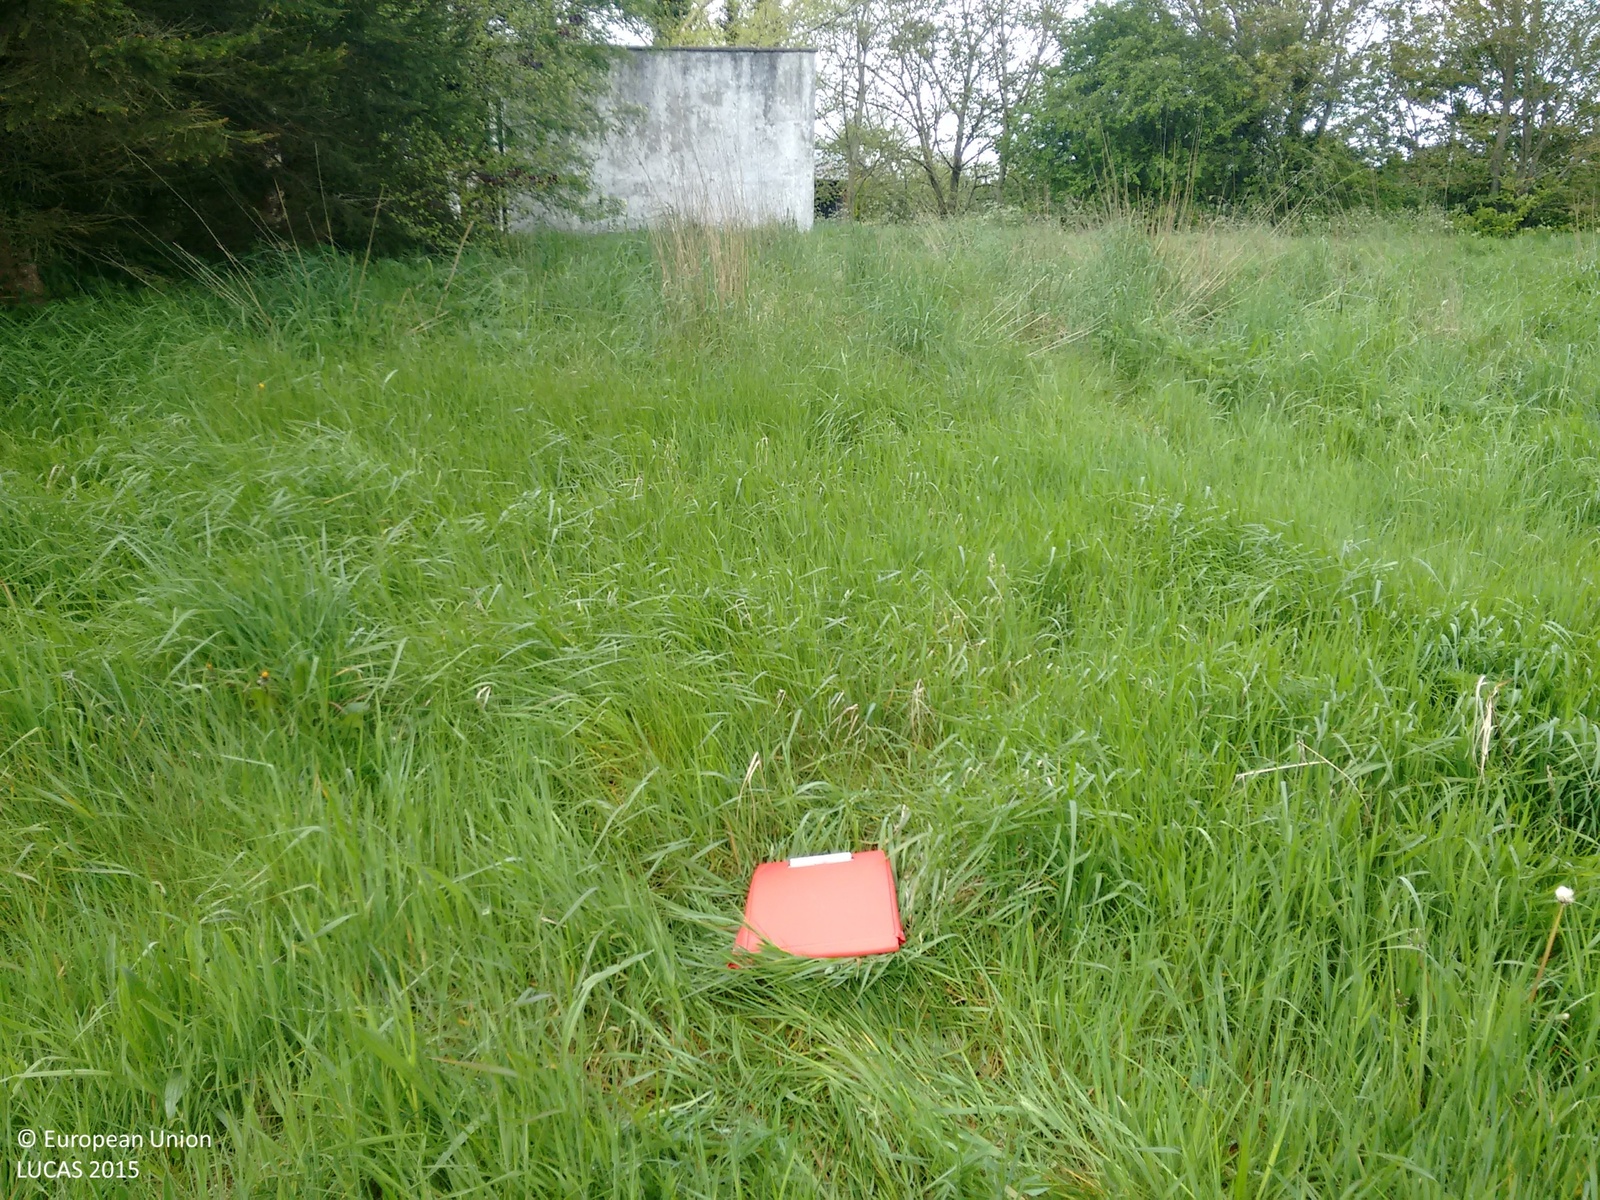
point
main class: Grassland
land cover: Grassland without tree/shrub cover
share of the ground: > 75 %
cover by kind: herbaceous plants 100 %
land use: Agriculture (excluding fallow land and kitchen gardens)
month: May
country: IE
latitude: 53.2990
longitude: -6.6824
